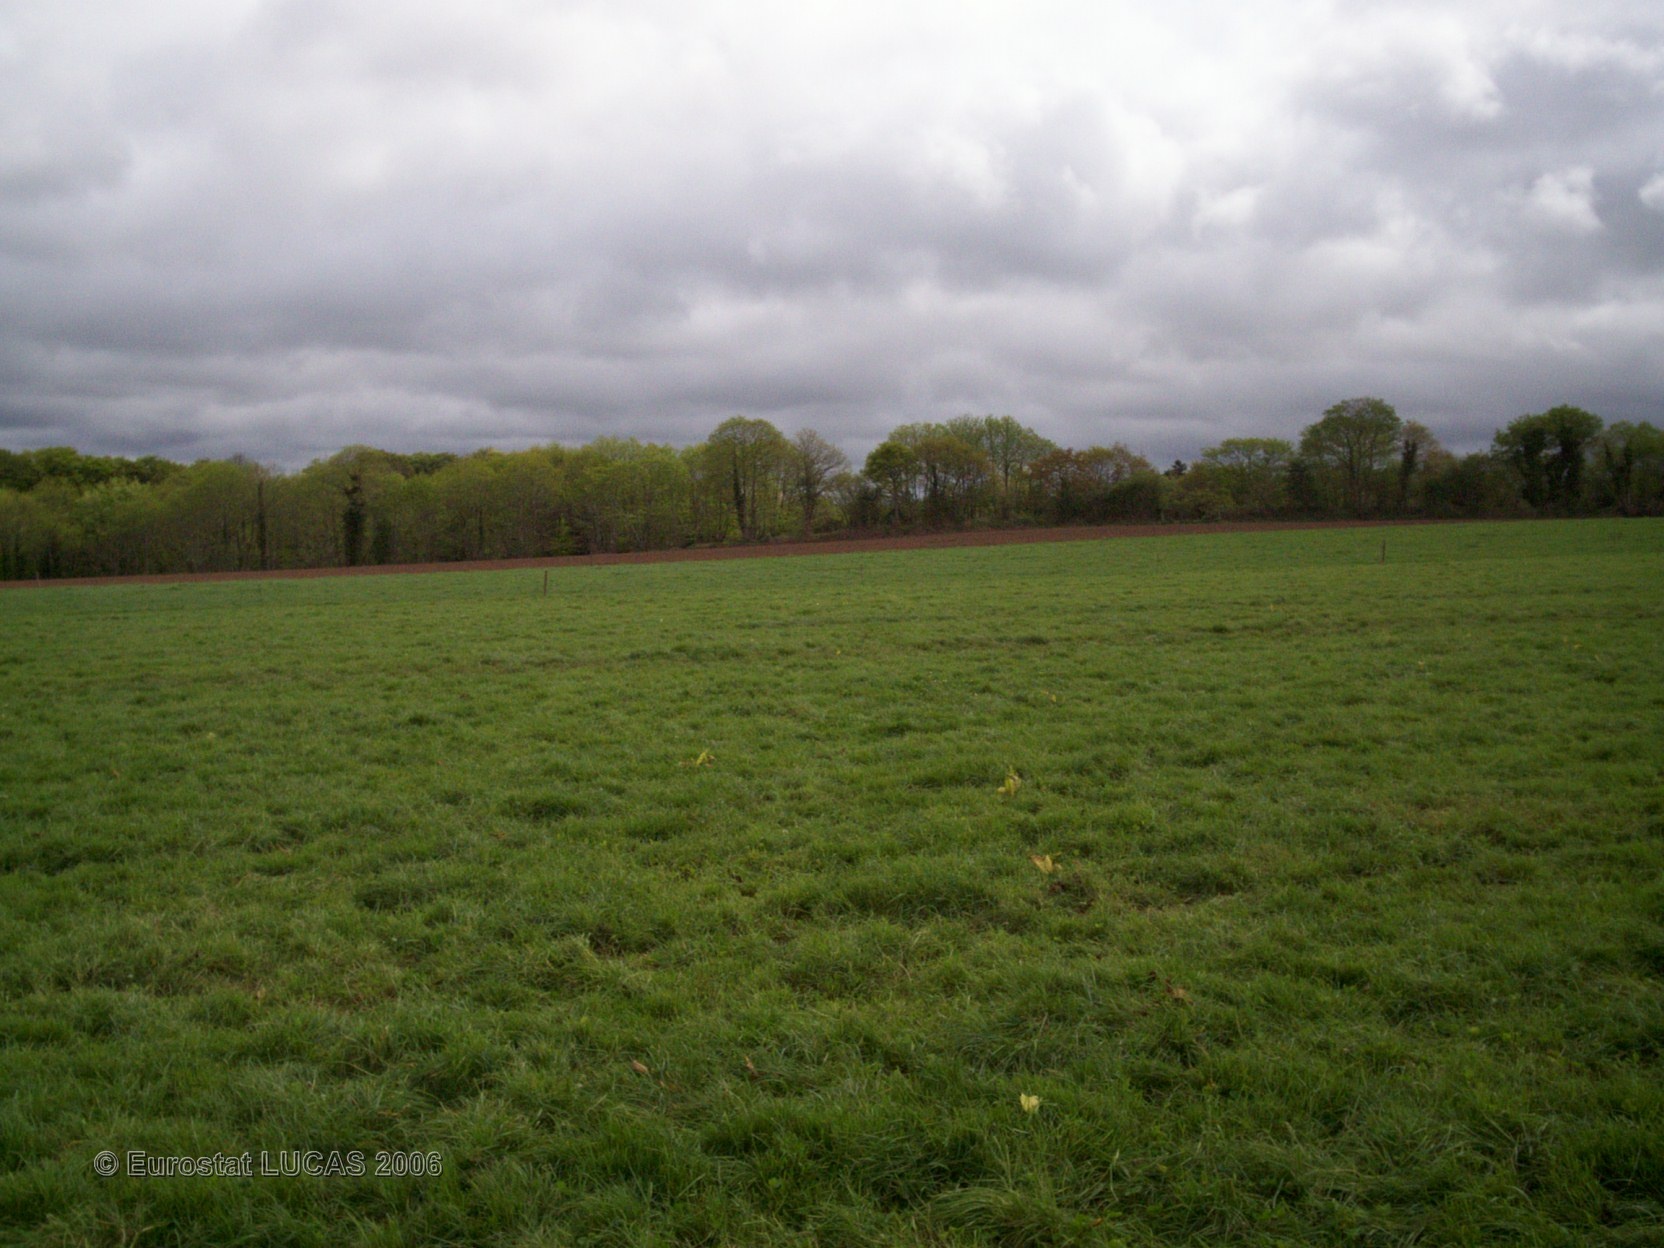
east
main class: Grassland
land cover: Grassland without tree/shrub cover
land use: Agriculture (excluding fallow land and kitchen gardens)
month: May
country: FR
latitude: 48.5110
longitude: -3.7145
